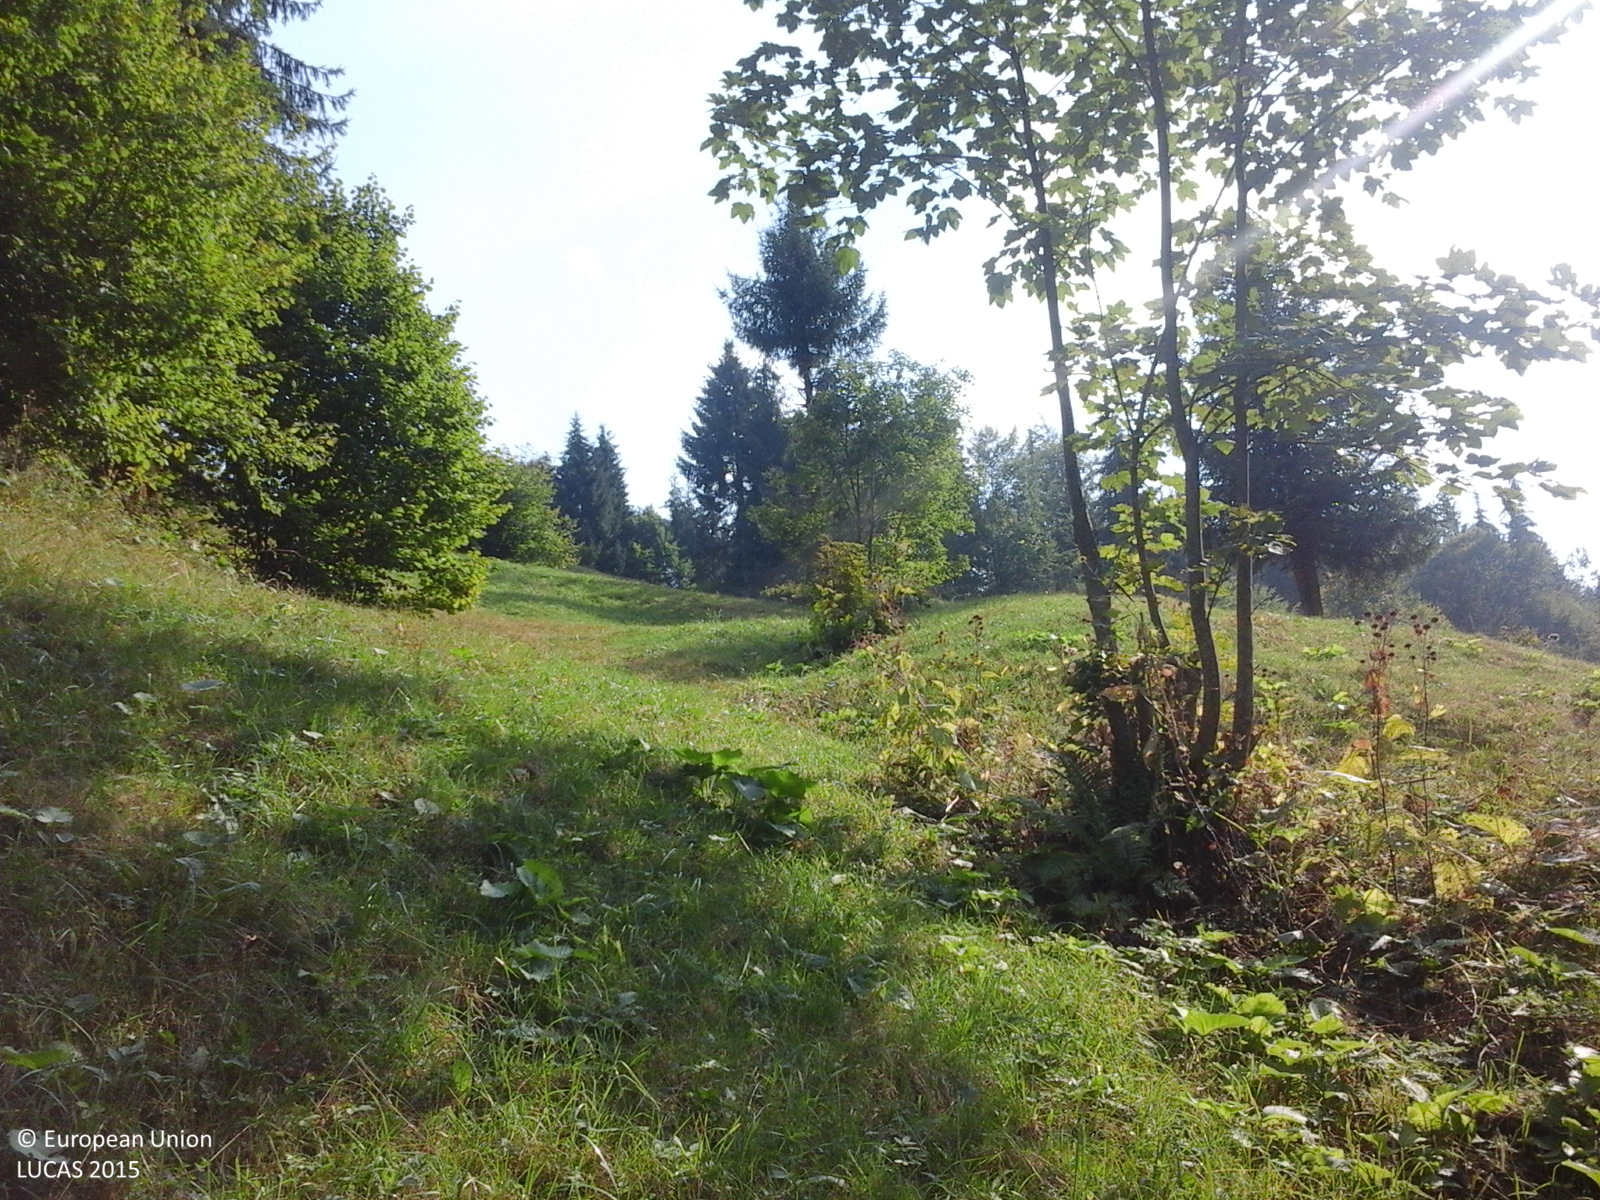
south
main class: Grassland
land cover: Grassland without tree/shrub cover
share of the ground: > 75 %
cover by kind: herbaceous plants 100 %
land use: Agriculture (excluding fallow land and kitchen gardens)
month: September
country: RO
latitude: 47.7993
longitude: 24.4193
